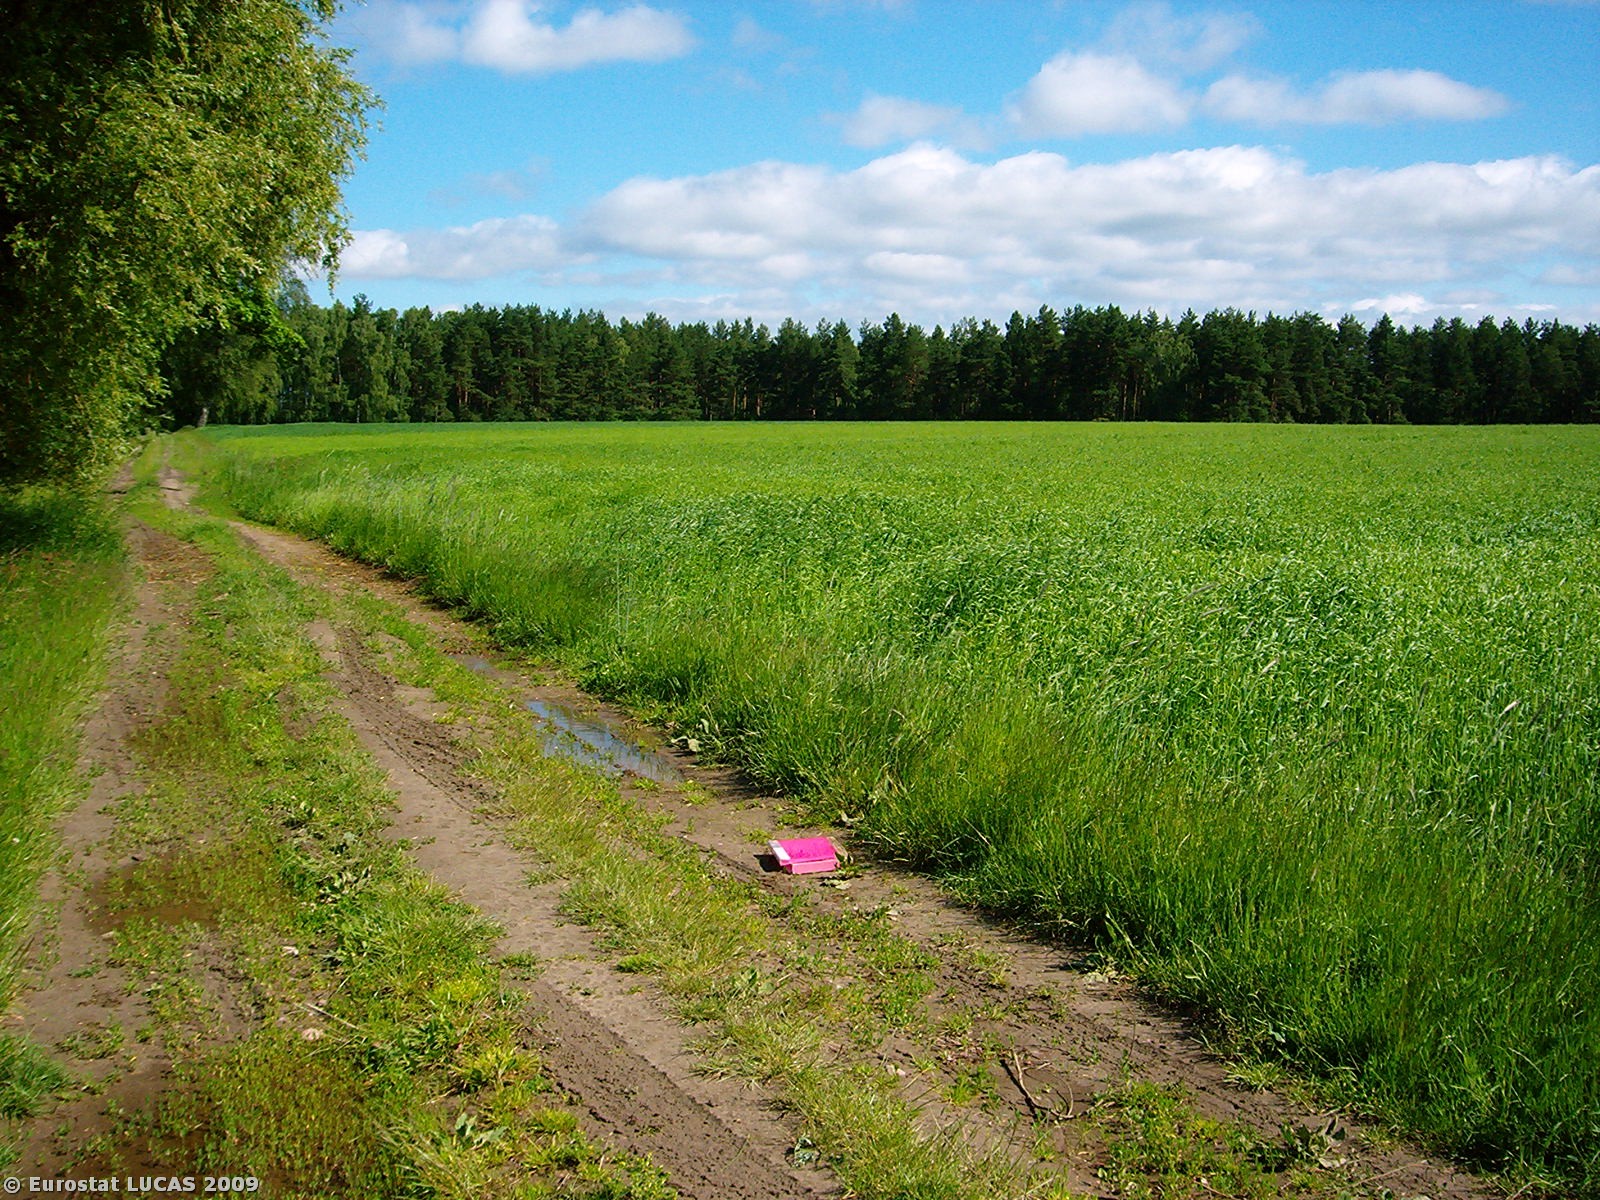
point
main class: Grassland
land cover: Spontaneously vegetated surfaces
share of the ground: > 75 %
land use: Road transport
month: June
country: PL
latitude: 53.7481
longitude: 17.1824
